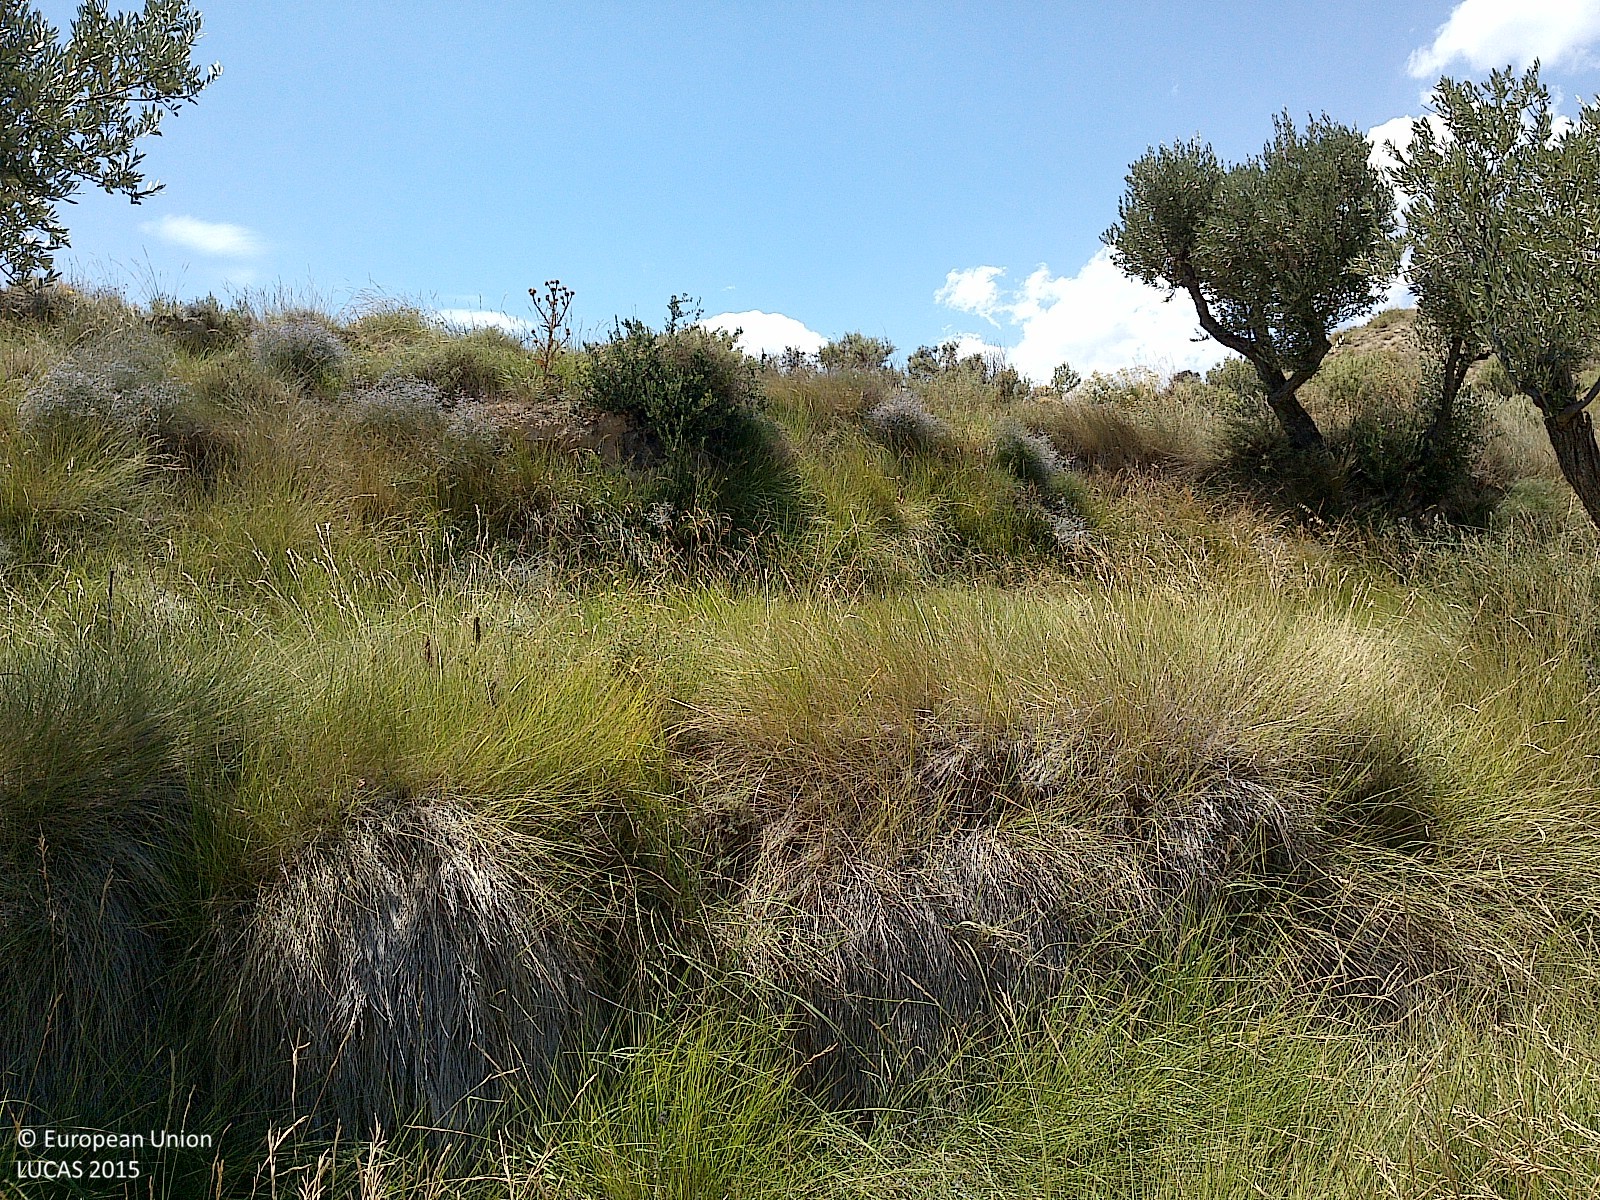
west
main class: Cropland
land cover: Olive groves
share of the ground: 10 - 25 %
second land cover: Grassland without tree/shrub cover
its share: > 75 %
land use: Agriculture (excluding fallow land and kitchen gardens)
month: July
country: ES
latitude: 41.9721
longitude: -2.0182
